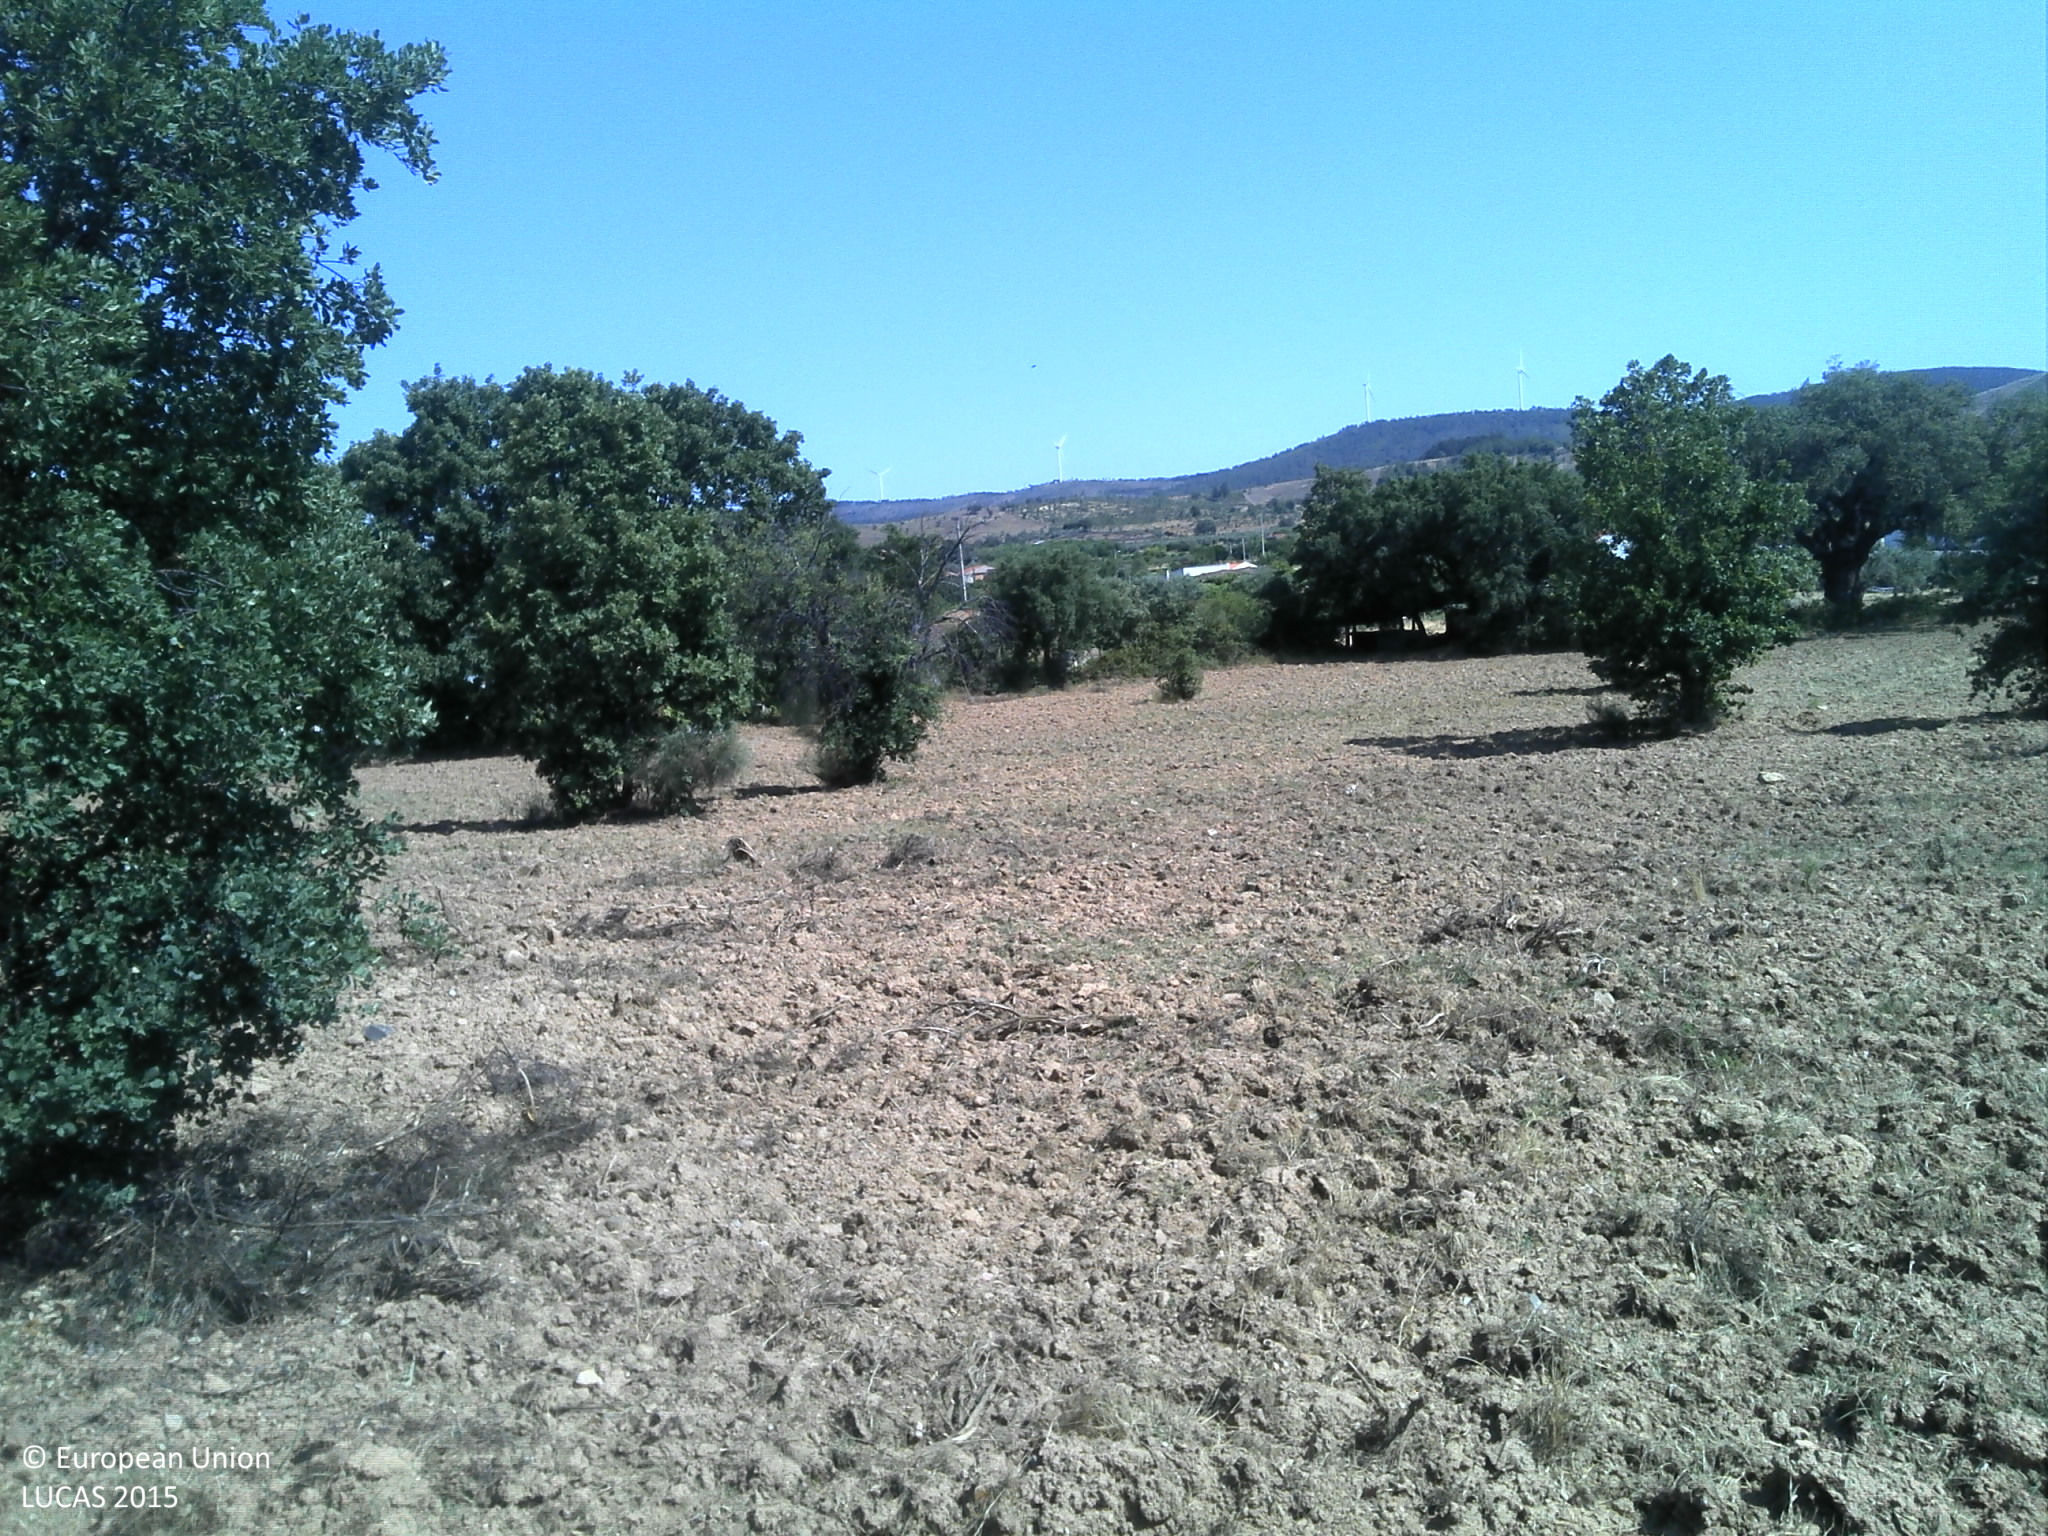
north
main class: Woodland
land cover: Broadleaved woodland
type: acidophilous oak and oak-birch forest
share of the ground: 25 - 50 %
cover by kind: broadleaved forest trees 50 %, unconsolidated bare surface 40 %, herbaceous plants 5 %
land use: Forestry
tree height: > 5 m
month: June
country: PT
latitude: 40.1634
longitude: -7.1570
